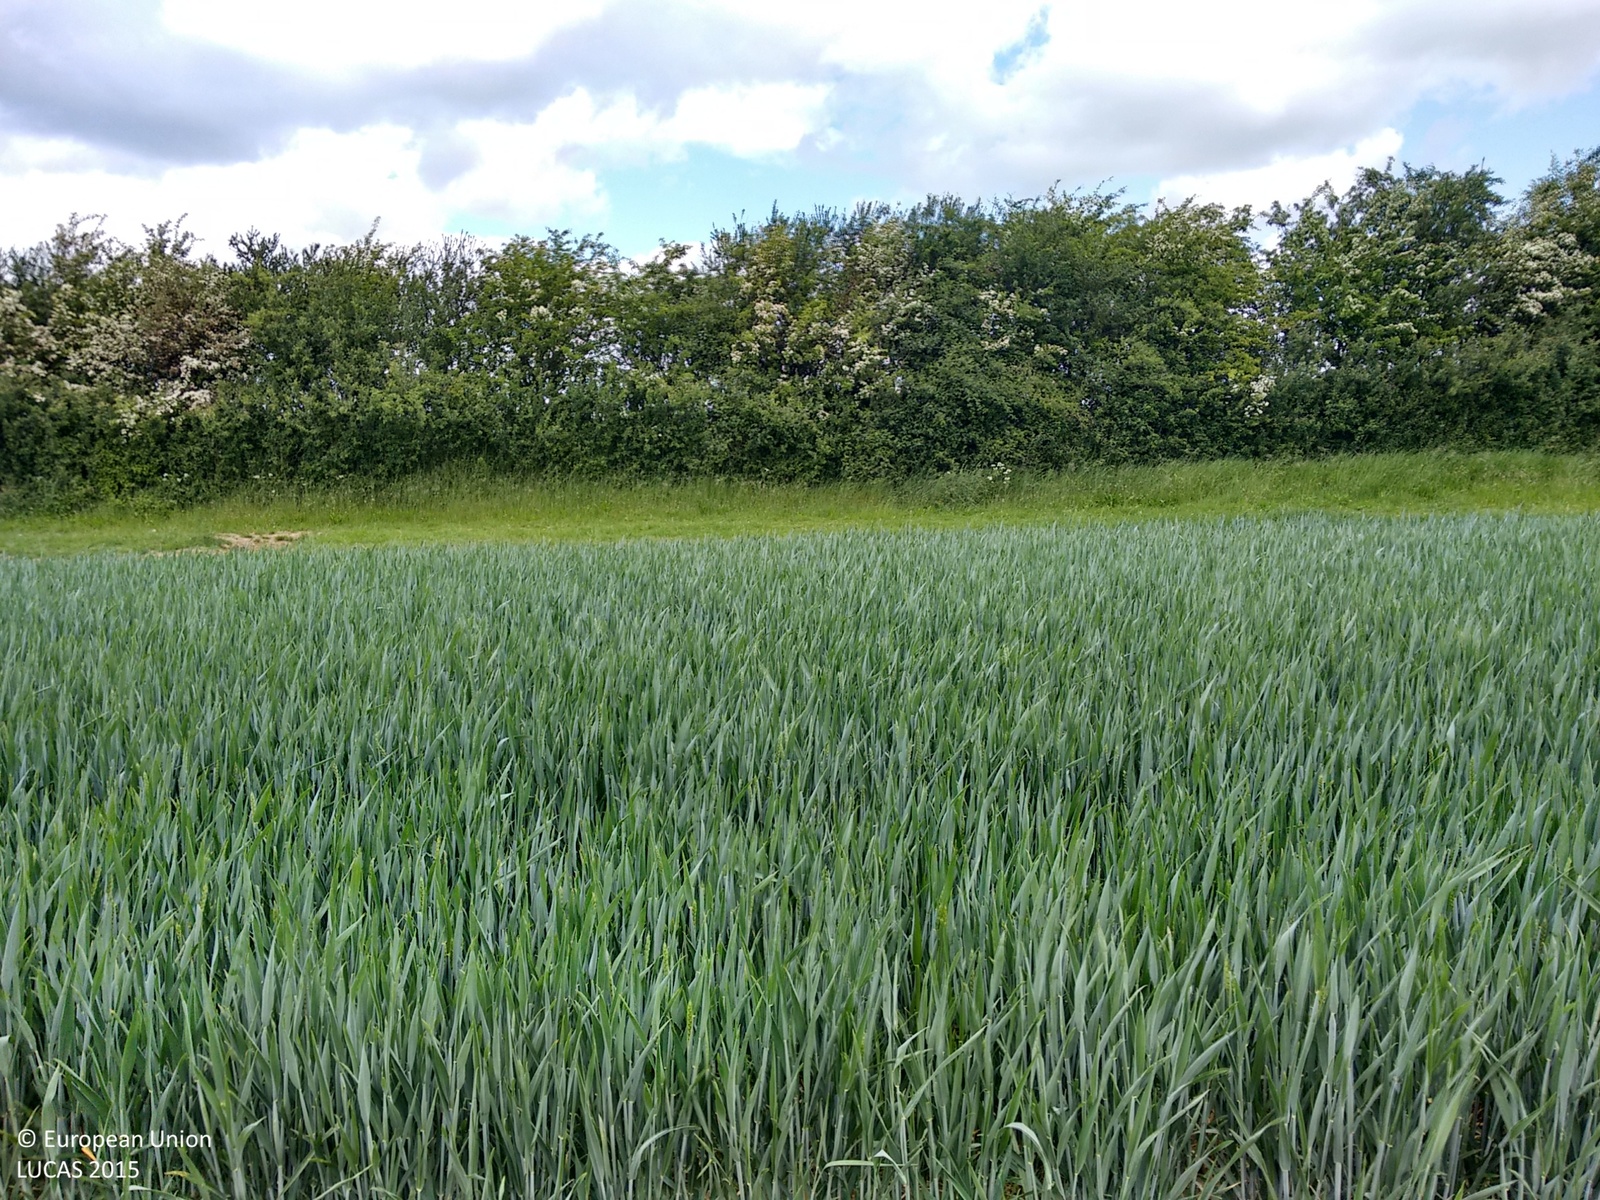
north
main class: Cropland
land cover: Common wheat
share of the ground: > 75 %
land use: Agriculture (excluding fallow land and kitchen gardens)
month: May
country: GB
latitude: 51.9260
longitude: 0.0943
